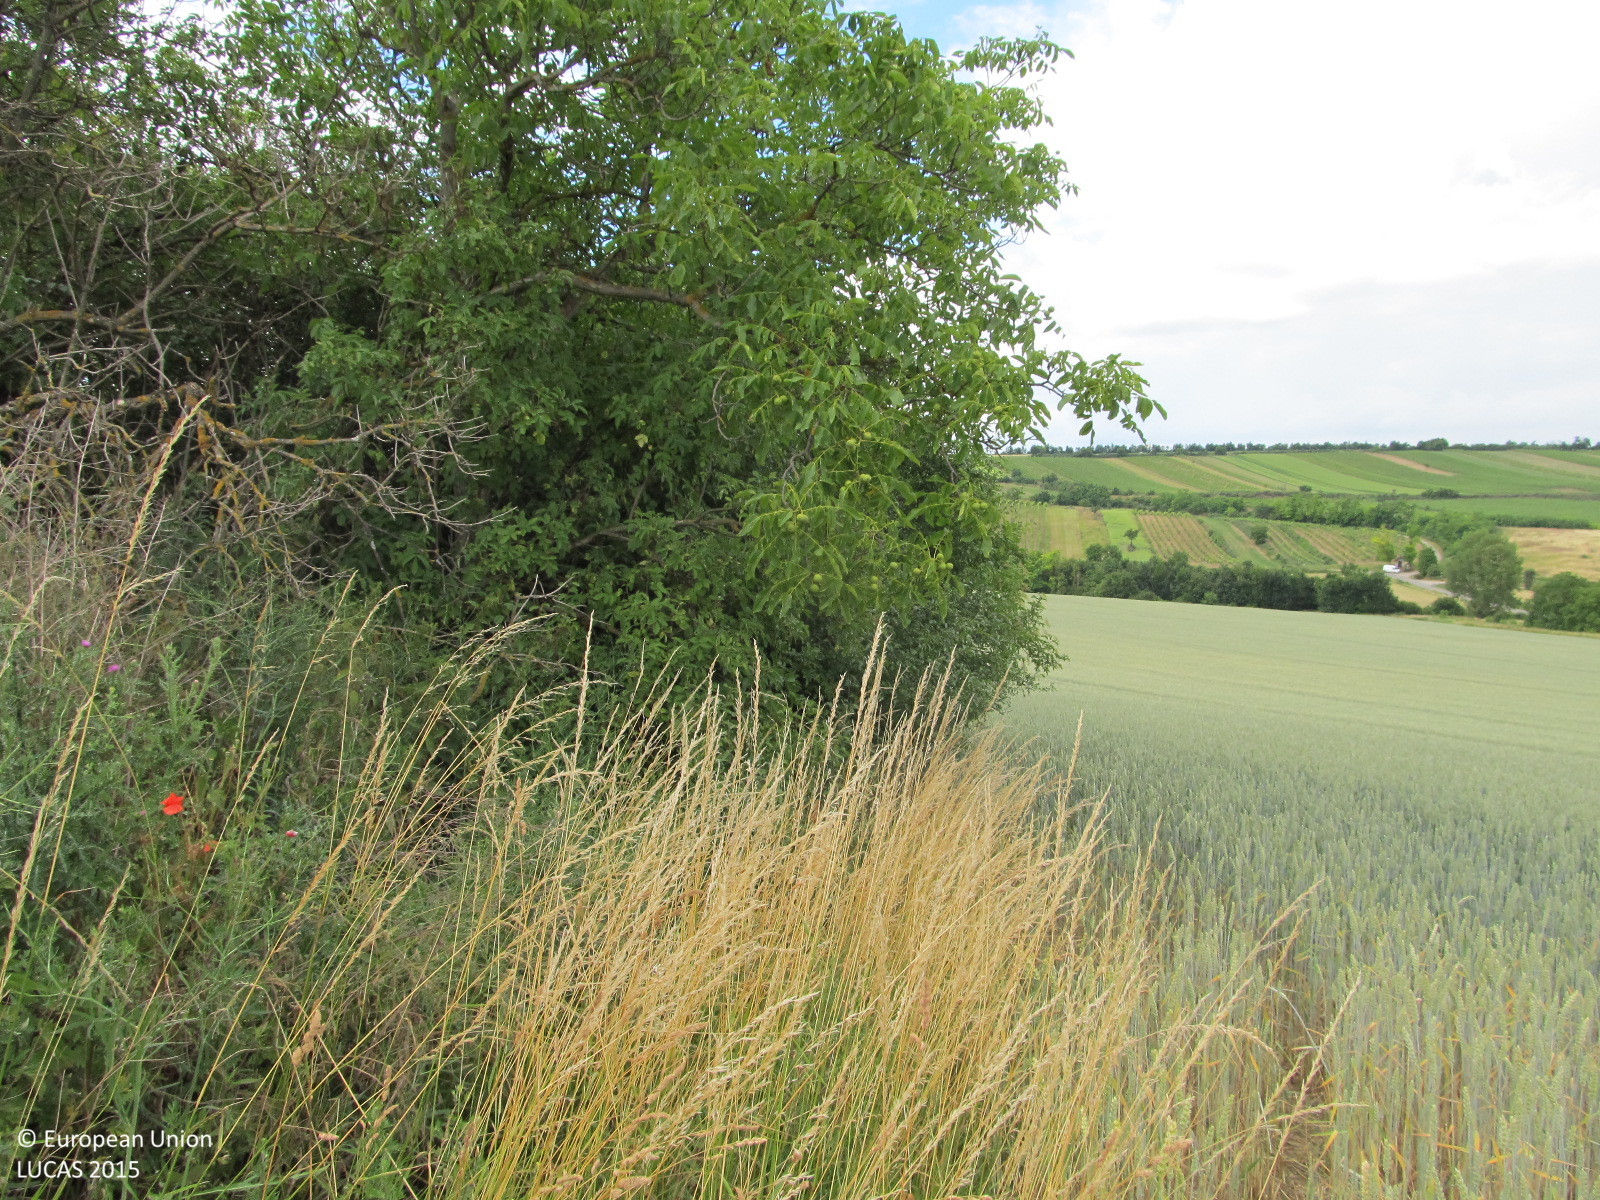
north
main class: Cropland
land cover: Common wheat
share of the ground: > 75 %
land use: Agriculture (excluding fallow land and kitchen gardens)
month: June
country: AT
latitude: 48.7367
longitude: 16.1647
